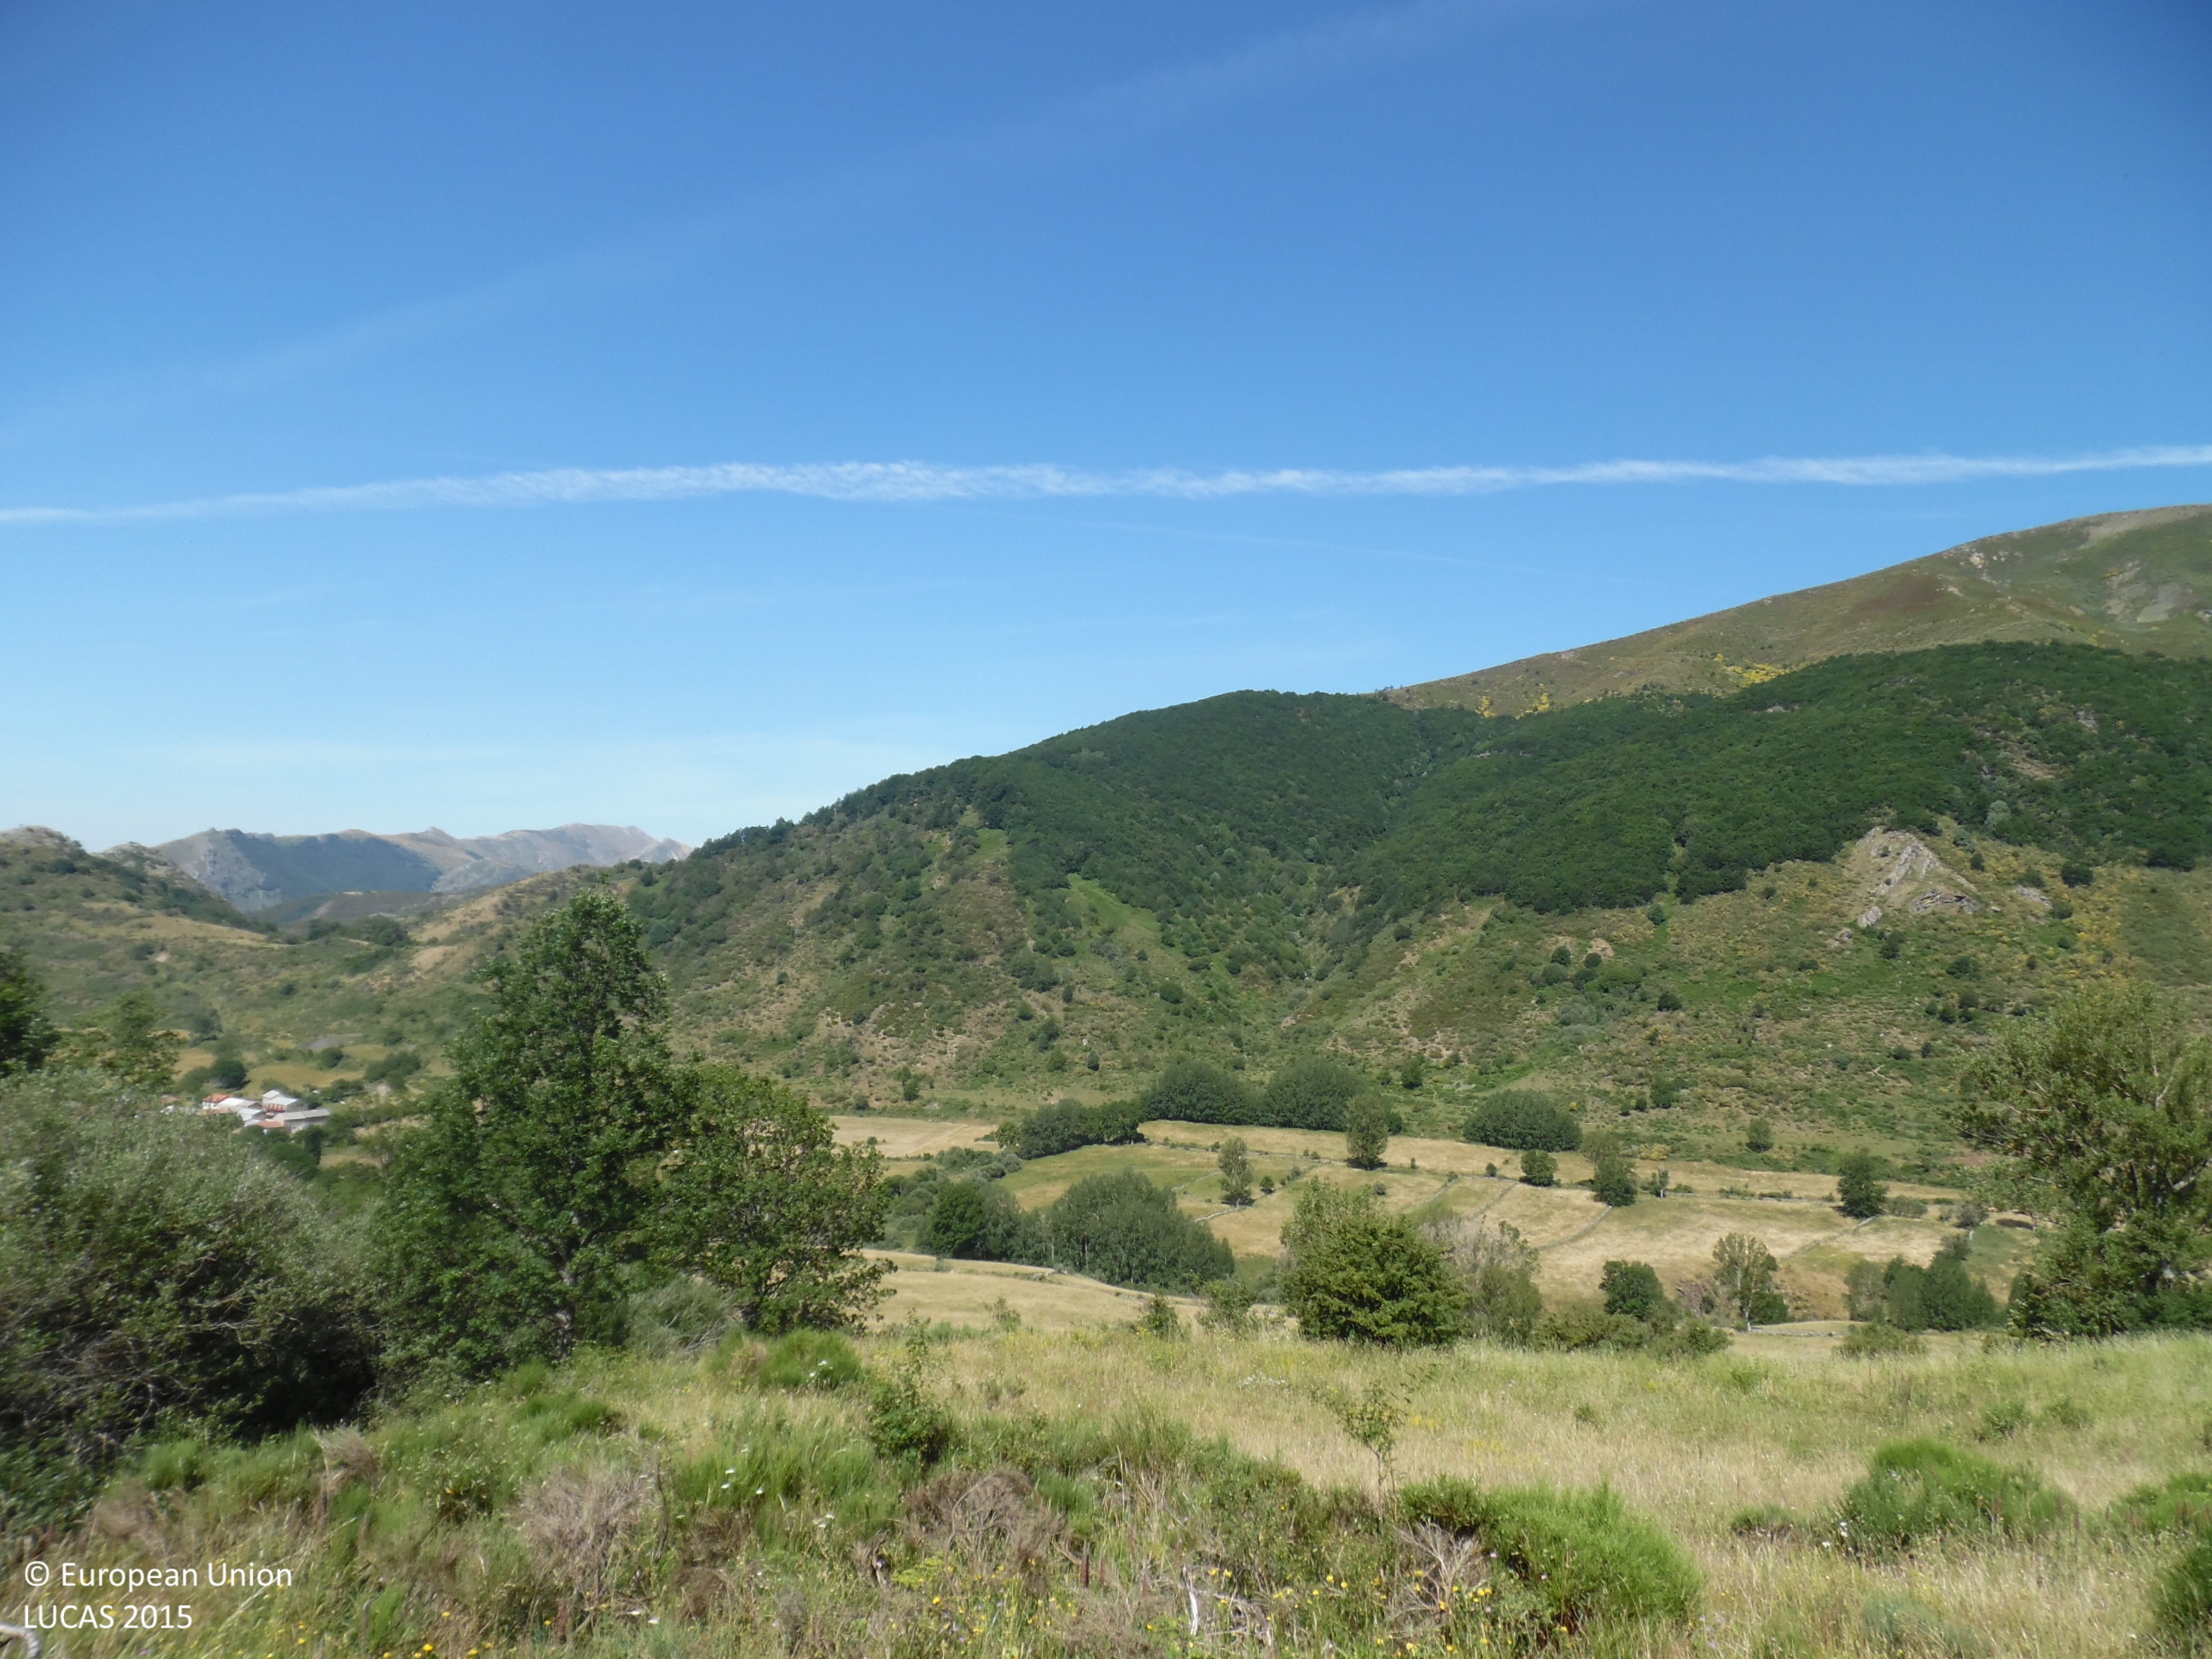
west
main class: Woodland
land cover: Broadleaved woodland
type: thermophilous deciduous forest
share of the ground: > 75 %
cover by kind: broadleaved forest trees 100 %
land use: Forestry
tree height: > 5 m
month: July
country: ES
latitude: 42.9912
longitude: -5.5179
